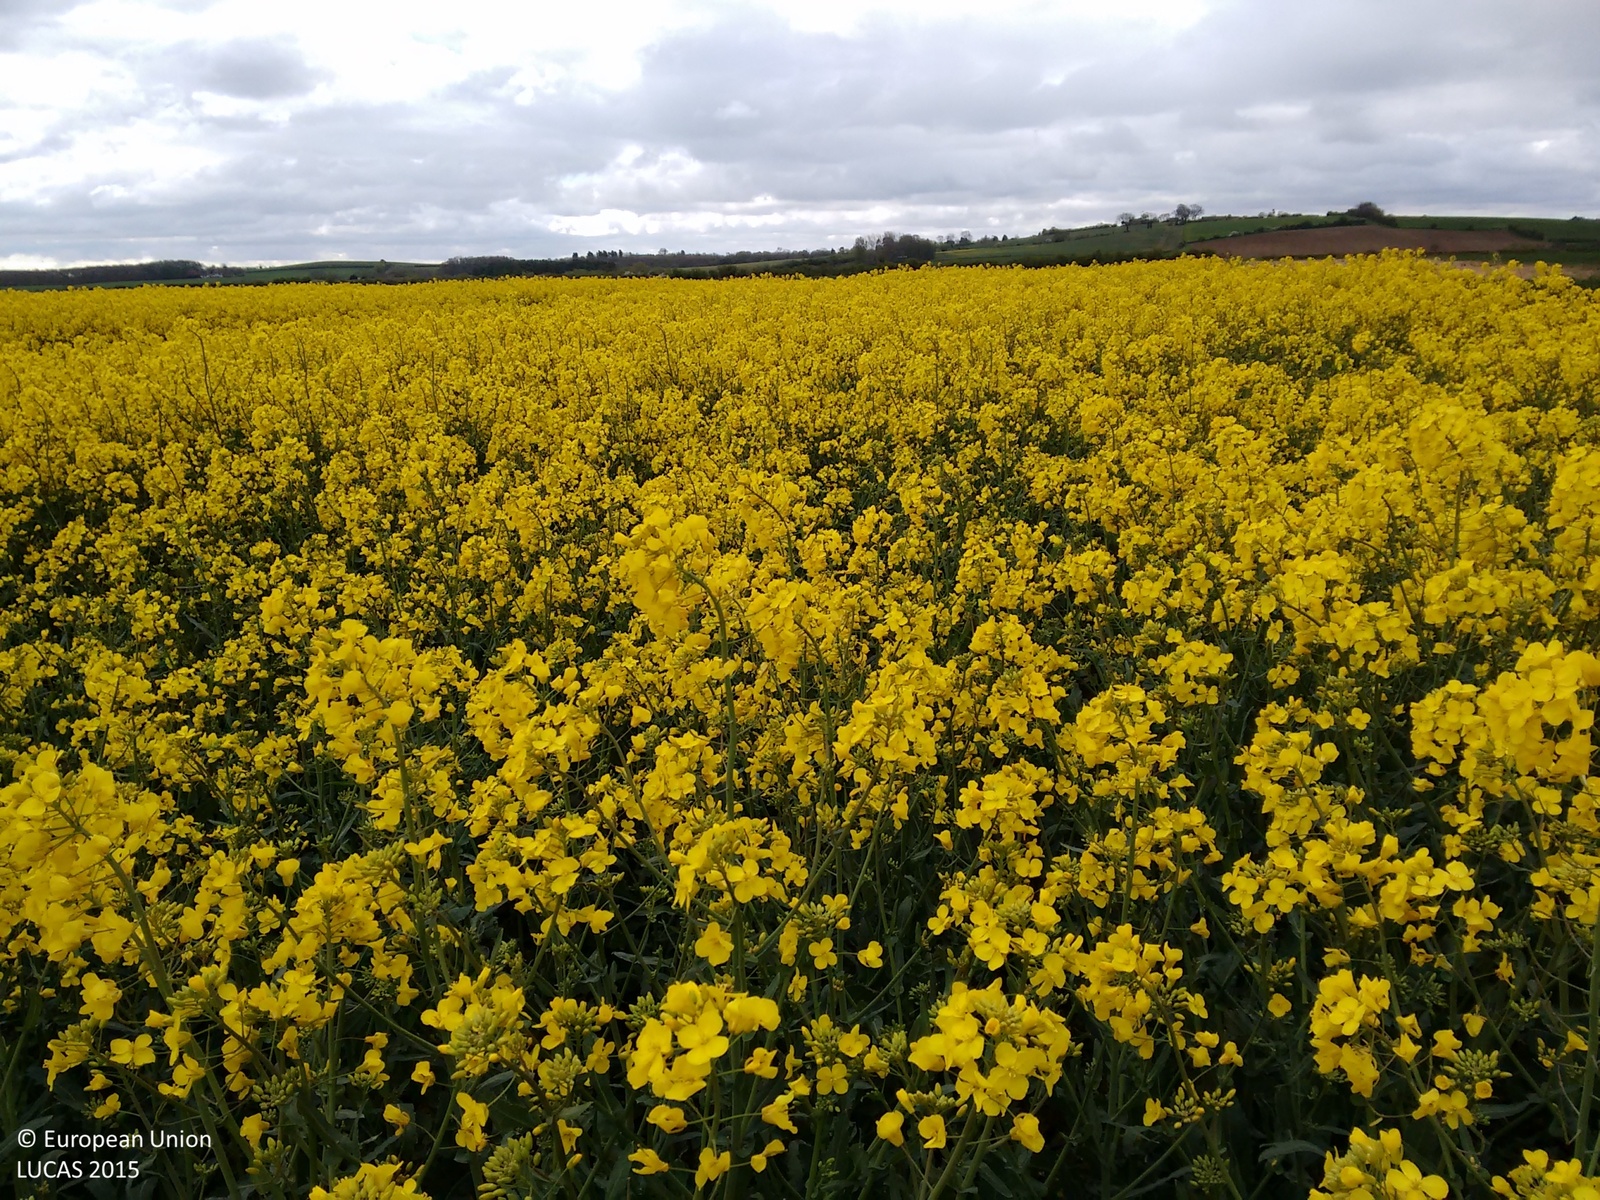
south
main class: Cropland
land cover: Rape and turnip rape
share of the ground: > 75 %
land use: Agriculture (excluding fallow land and kitchen gardens)
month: April
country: GB
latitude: 53.2232
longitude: 0.0077
